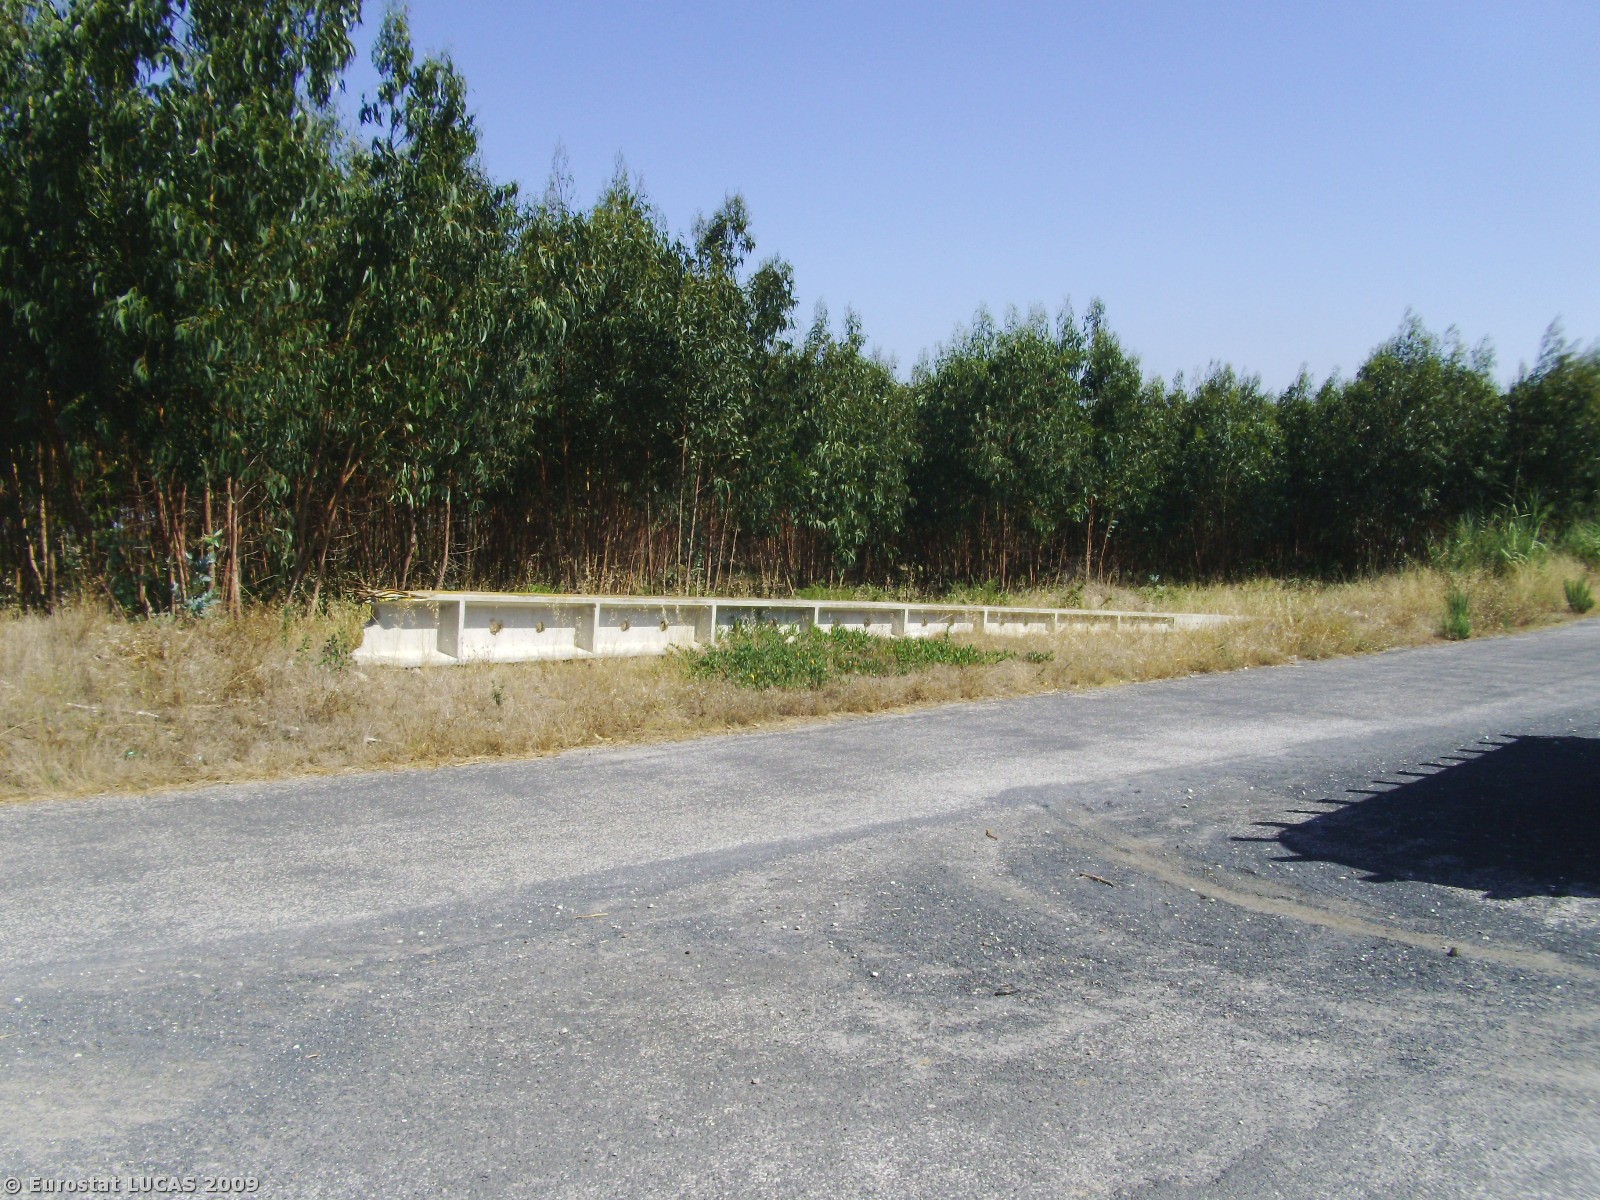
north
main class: Grassland
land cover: Spontaneously vegetated surfaces
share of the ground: > 75 %
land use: Fallow land
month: July
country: PT
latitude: 39.1530
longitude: -9.3573
